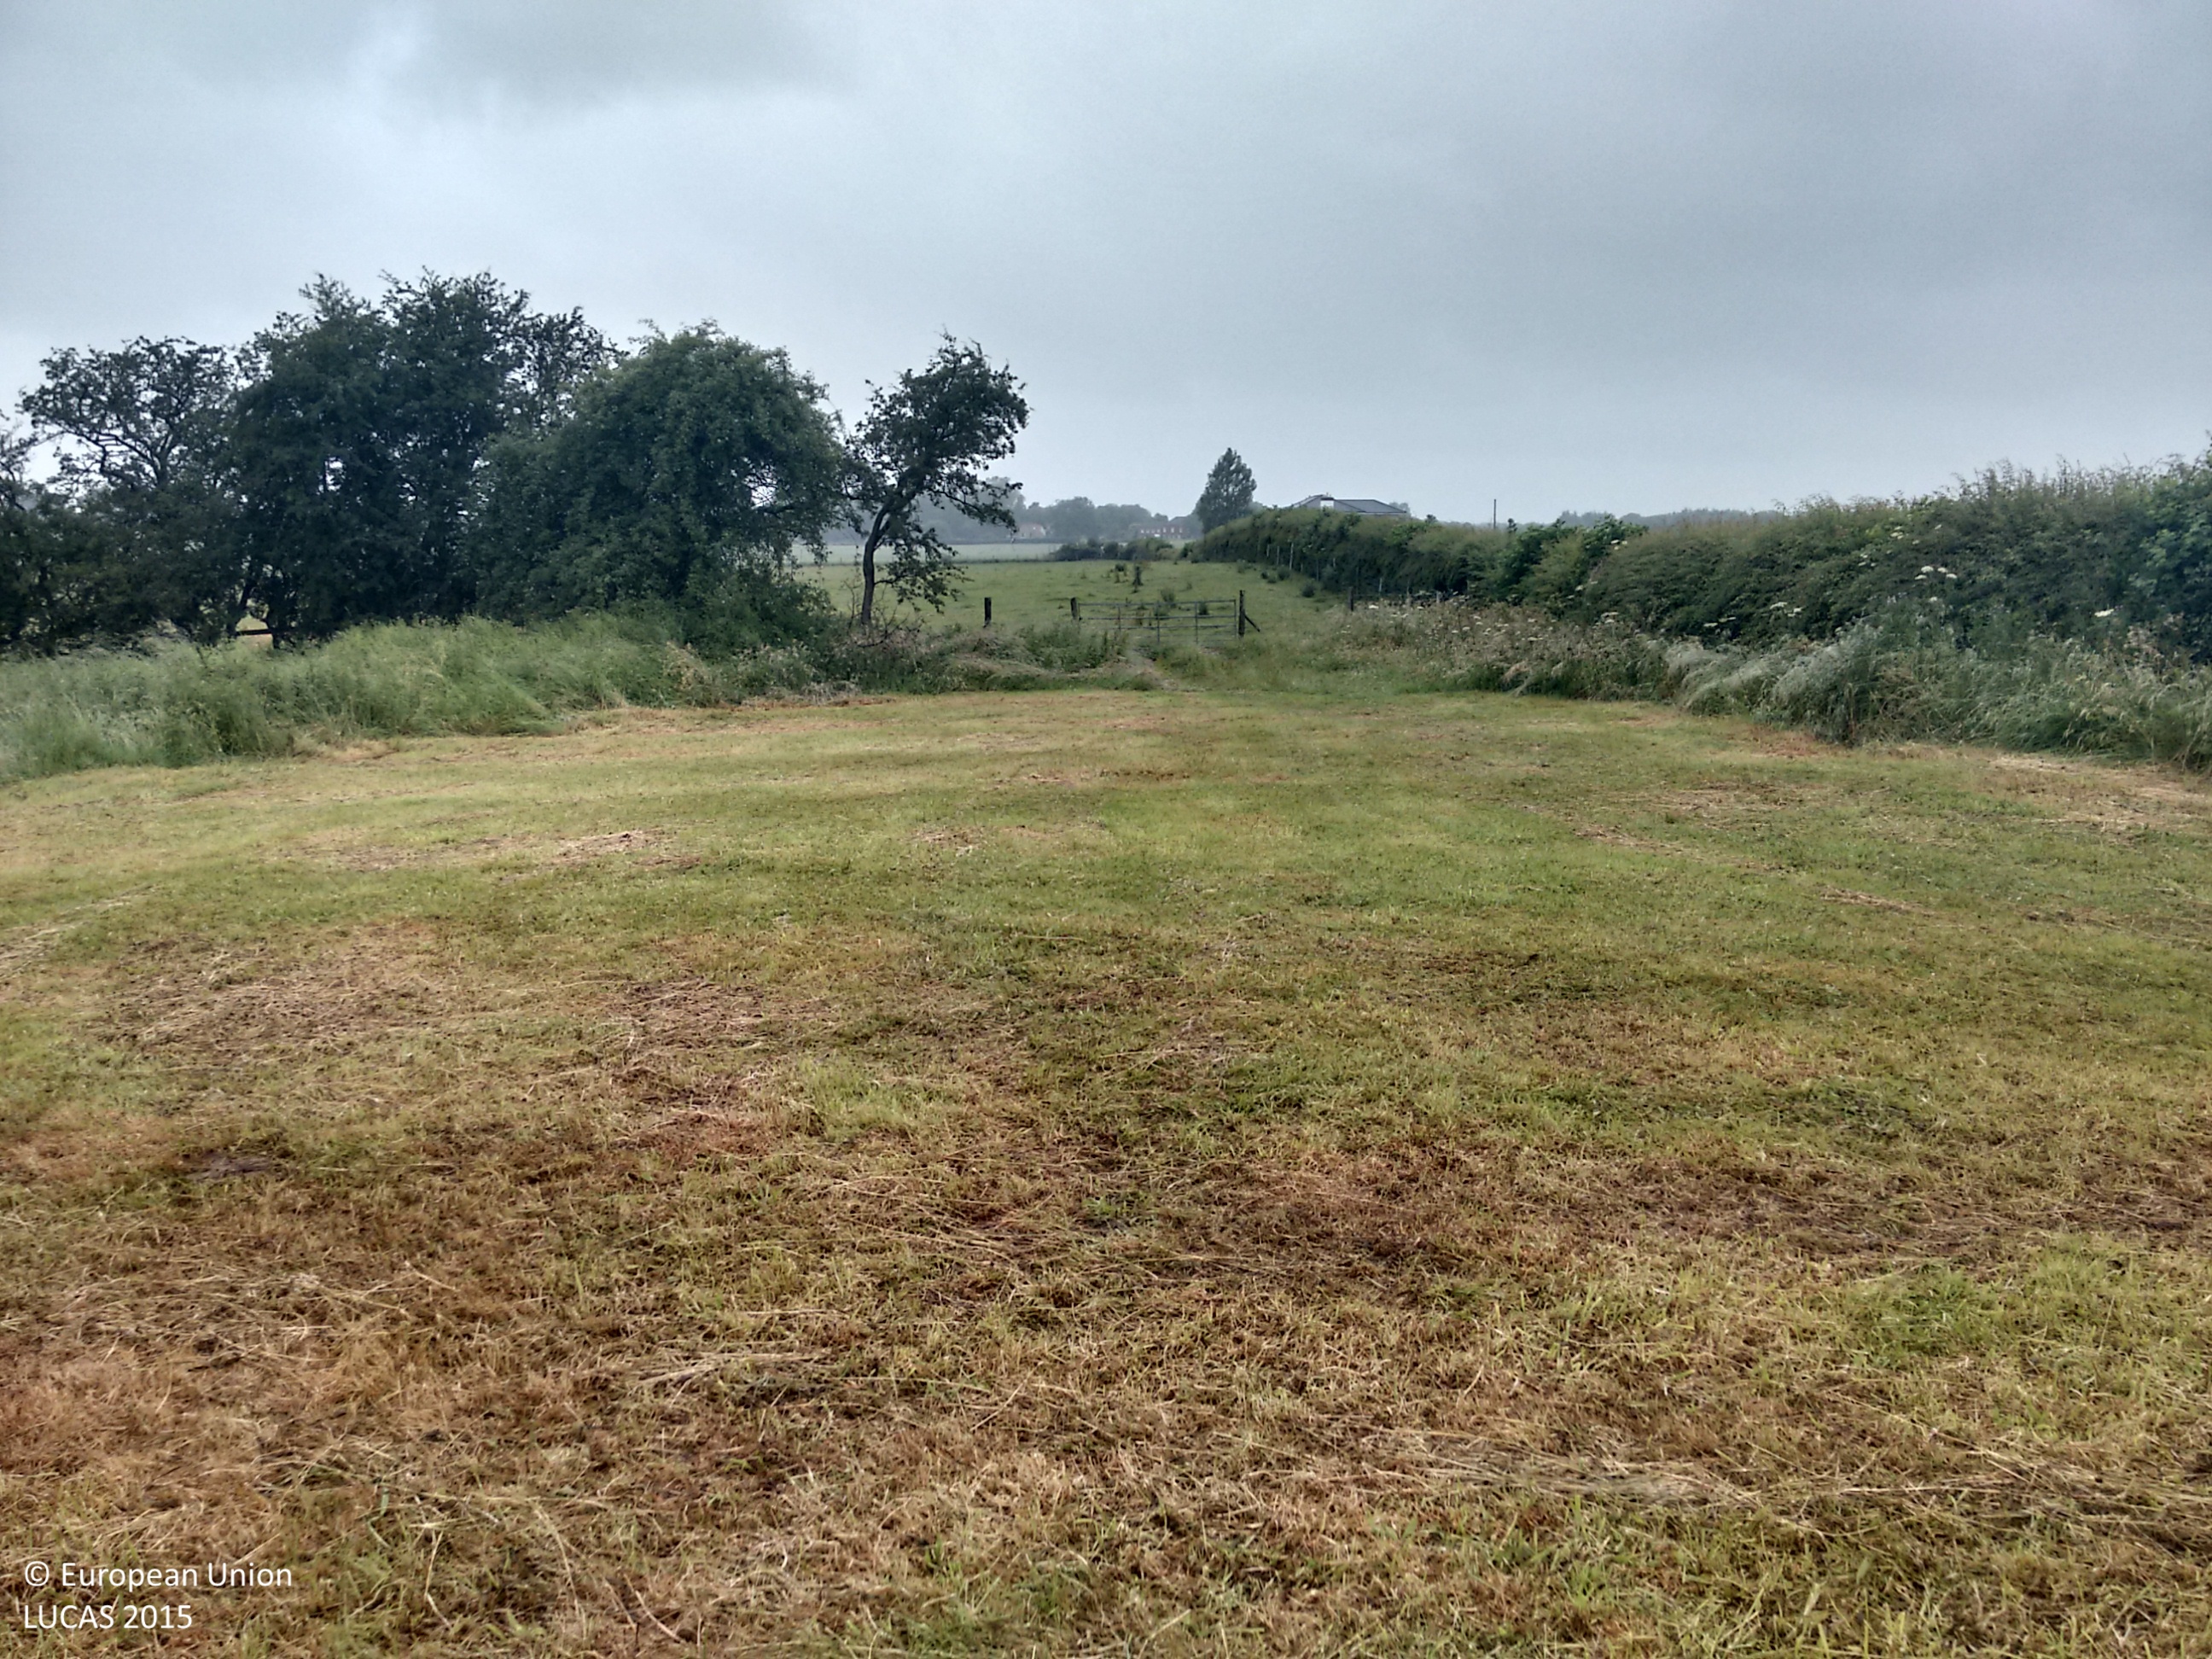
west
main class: Grassland
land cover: Grassland without tree/shrub cover
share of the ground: > 75 %
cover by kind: herbaceous plants 100 %
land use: Agriculture (excluding fallow land and kitchen gardens)
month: July
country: GB
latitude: 54.5194
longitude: -1.1513
